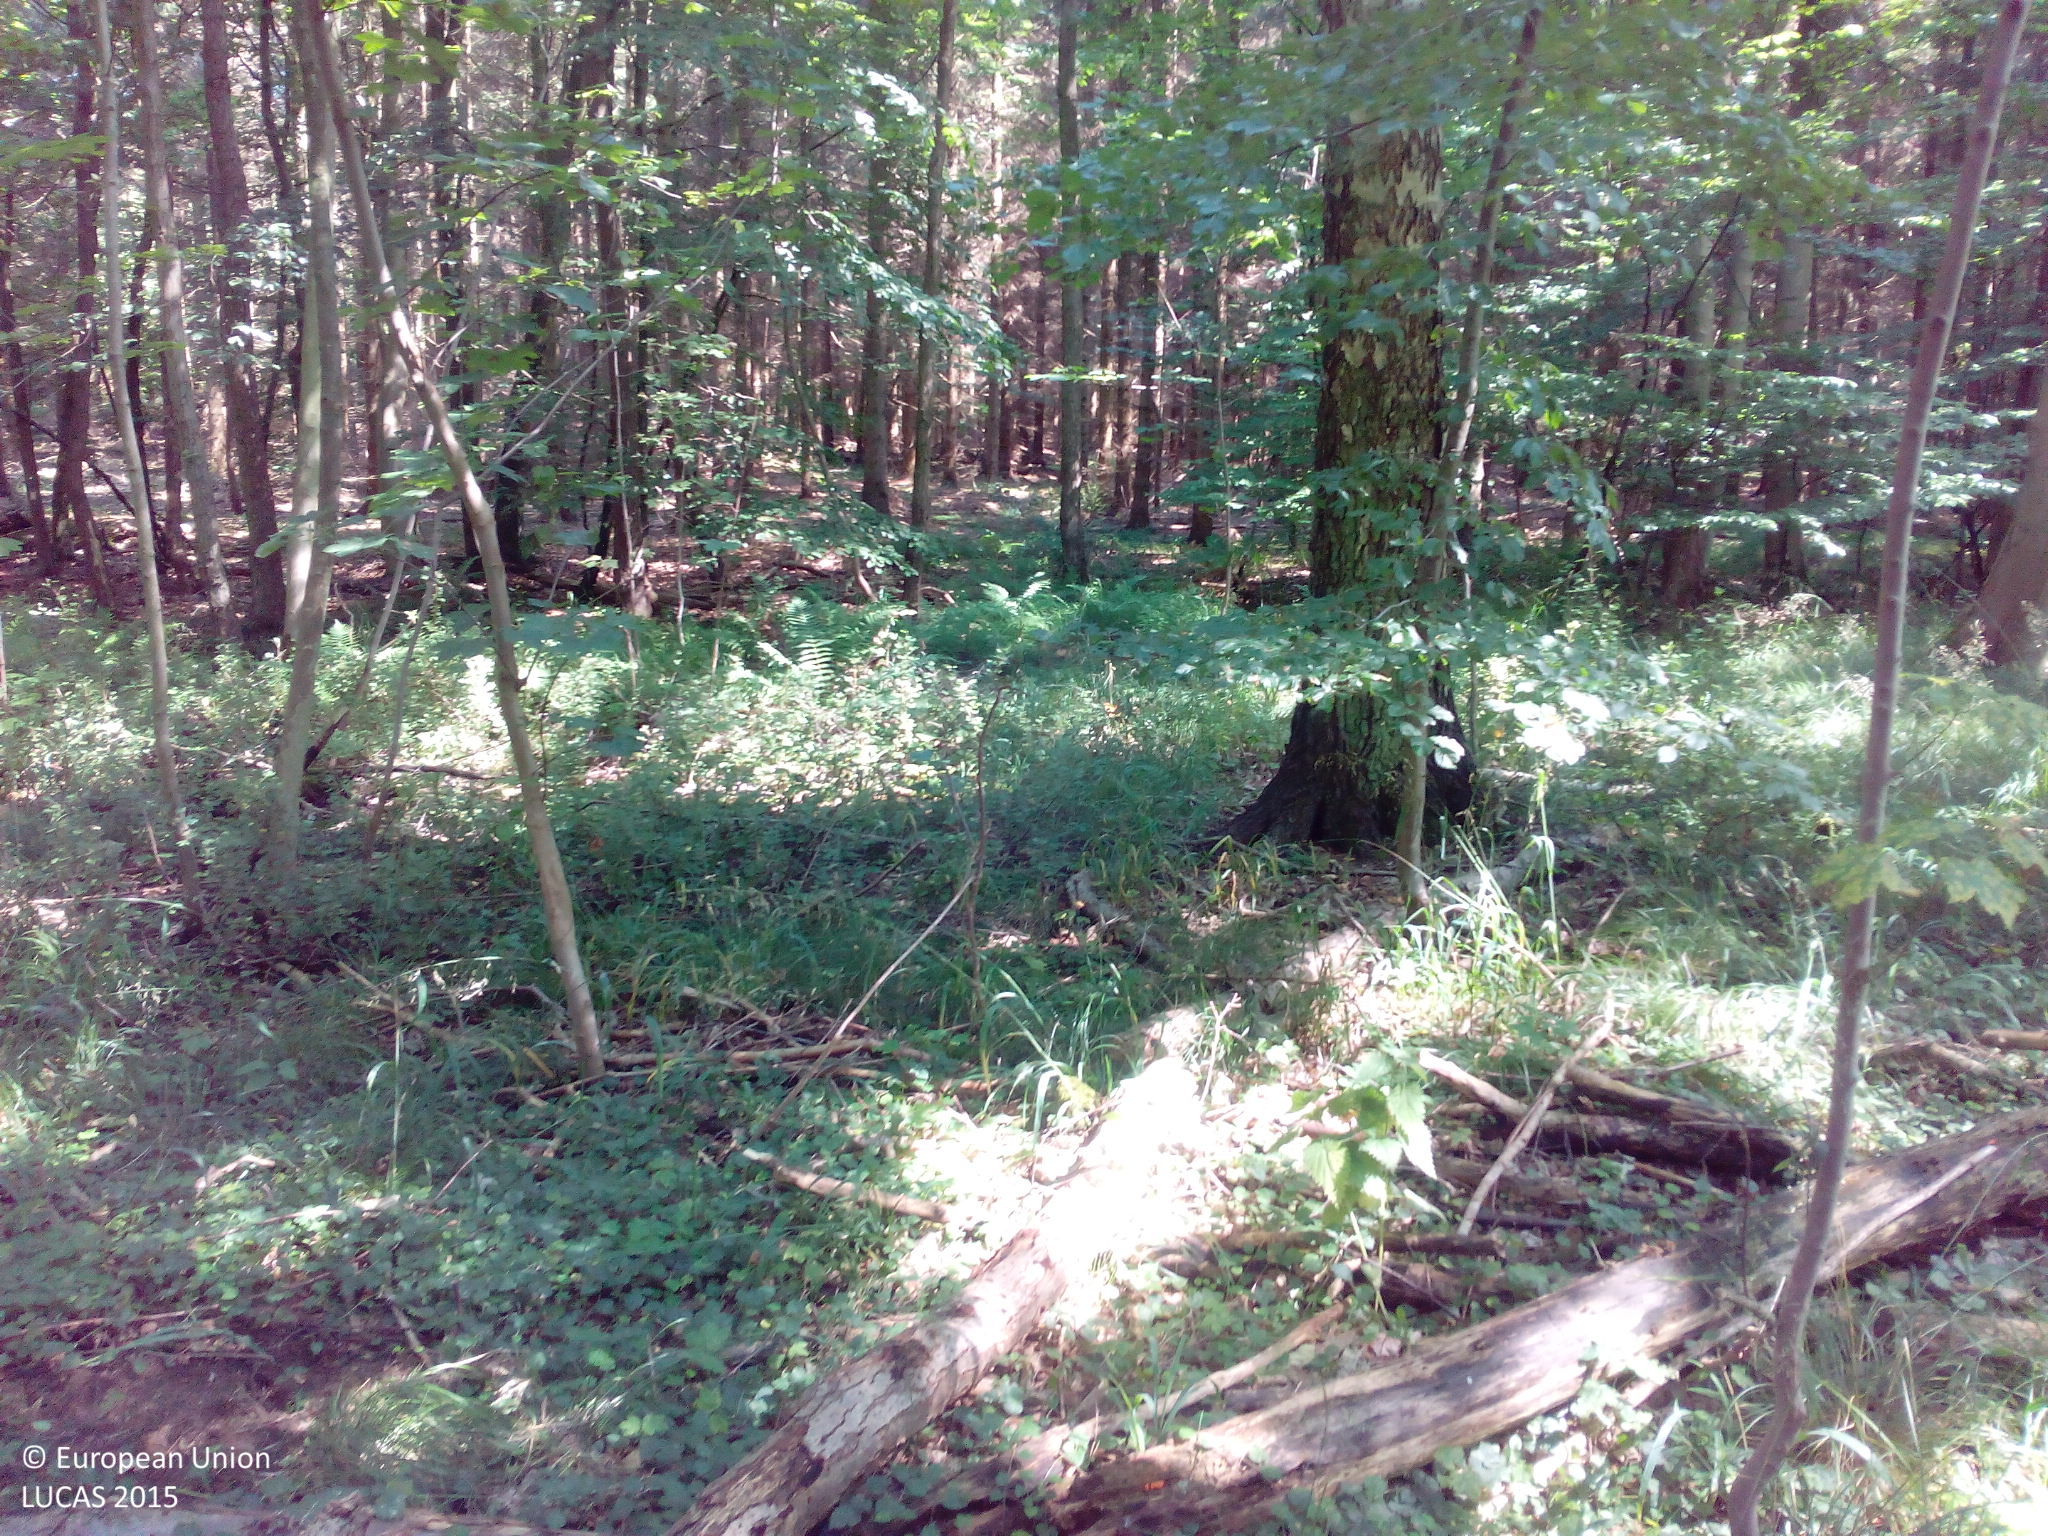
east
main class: Woodland
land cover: Broadleaved woodland
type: beech forest
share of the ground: > 75 %
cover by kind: broadleaved forest trees 100 %
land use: Forestry
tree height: > 5 m
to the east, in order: Broadleaved woodland; Ditches and canals; Spruce dominated coniferous woodland; Tracks; Spruce dominated coniferous woodland; Ditches and canals; Spruce dominated coniferous woodland; Ditches and canals; Spruce dominated coniferous woodland; Broadleaved woodland
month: August
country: DK
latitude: 55.4508
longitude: 12.1328
